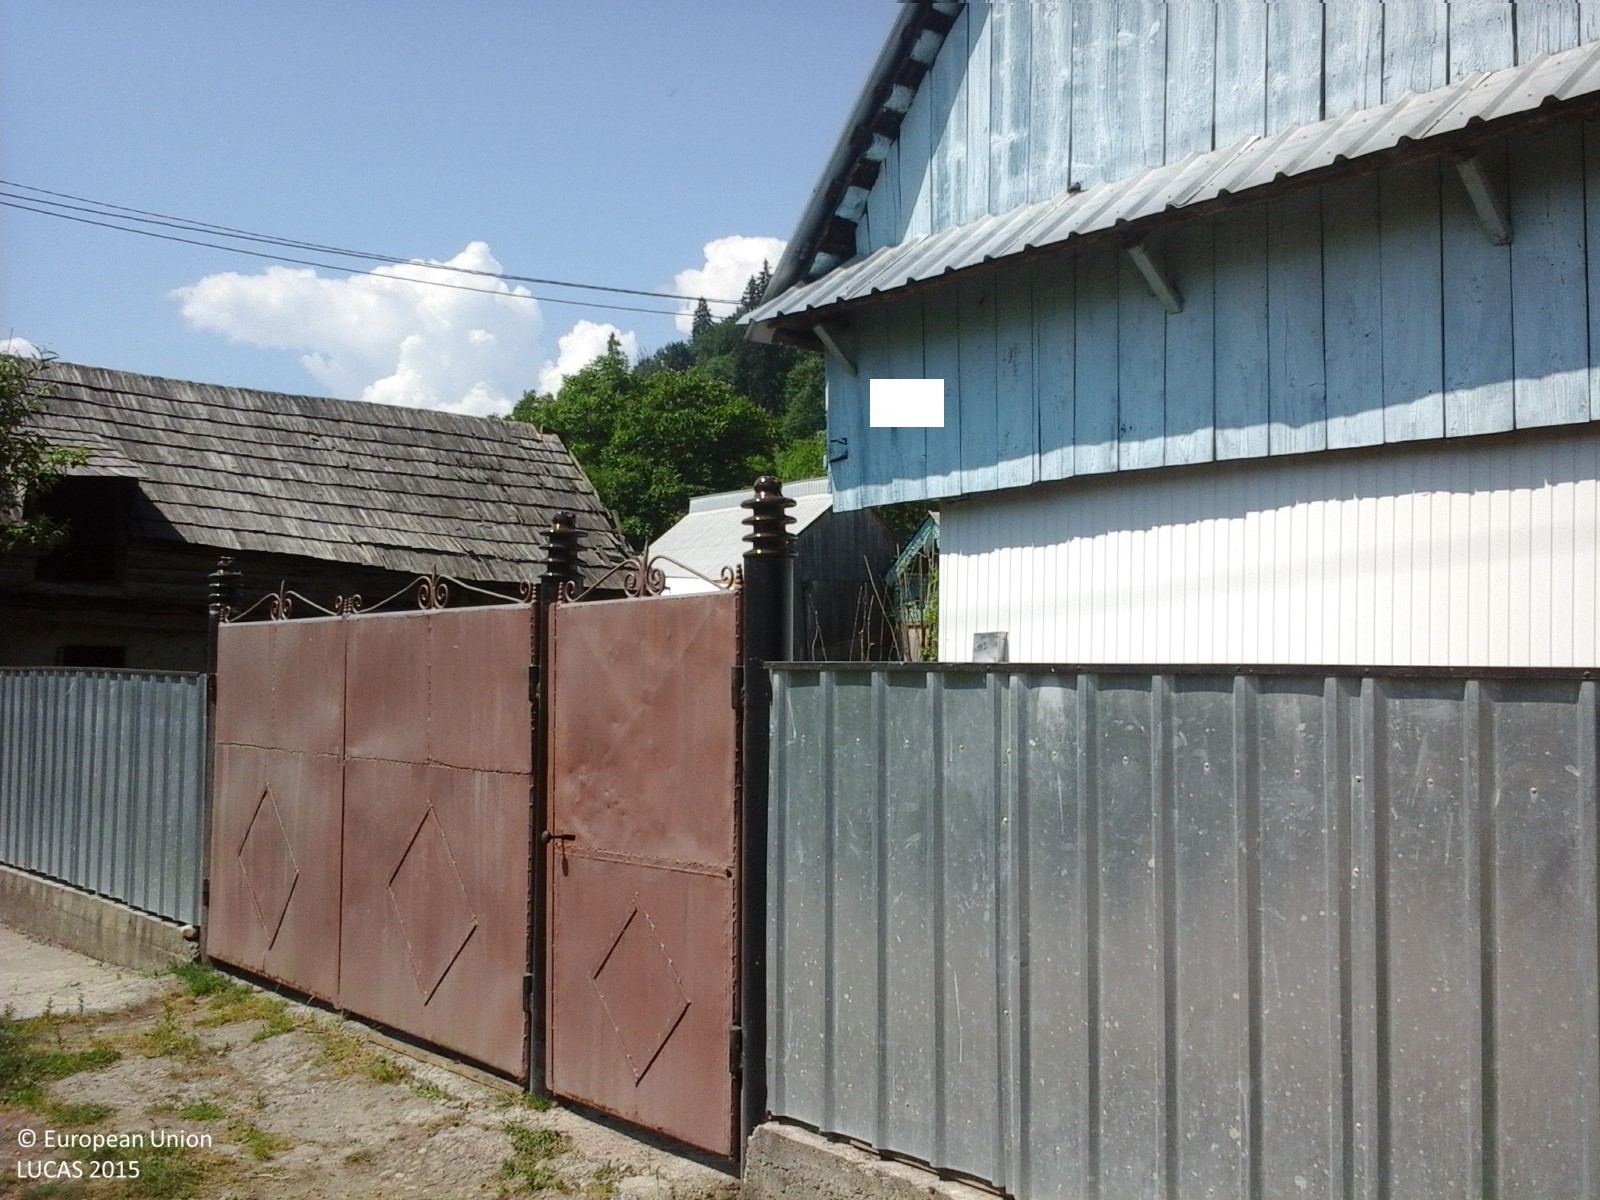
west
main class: Woodland
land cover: Other mixed woodland
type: beech forest
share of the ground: > 75 %
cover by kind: broadleaved forest trees 70 %, coniferous forest trees 30 %
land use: Forestry
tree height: > 5 m
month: June
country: RO
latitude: 46.6376
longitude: 26.5035
